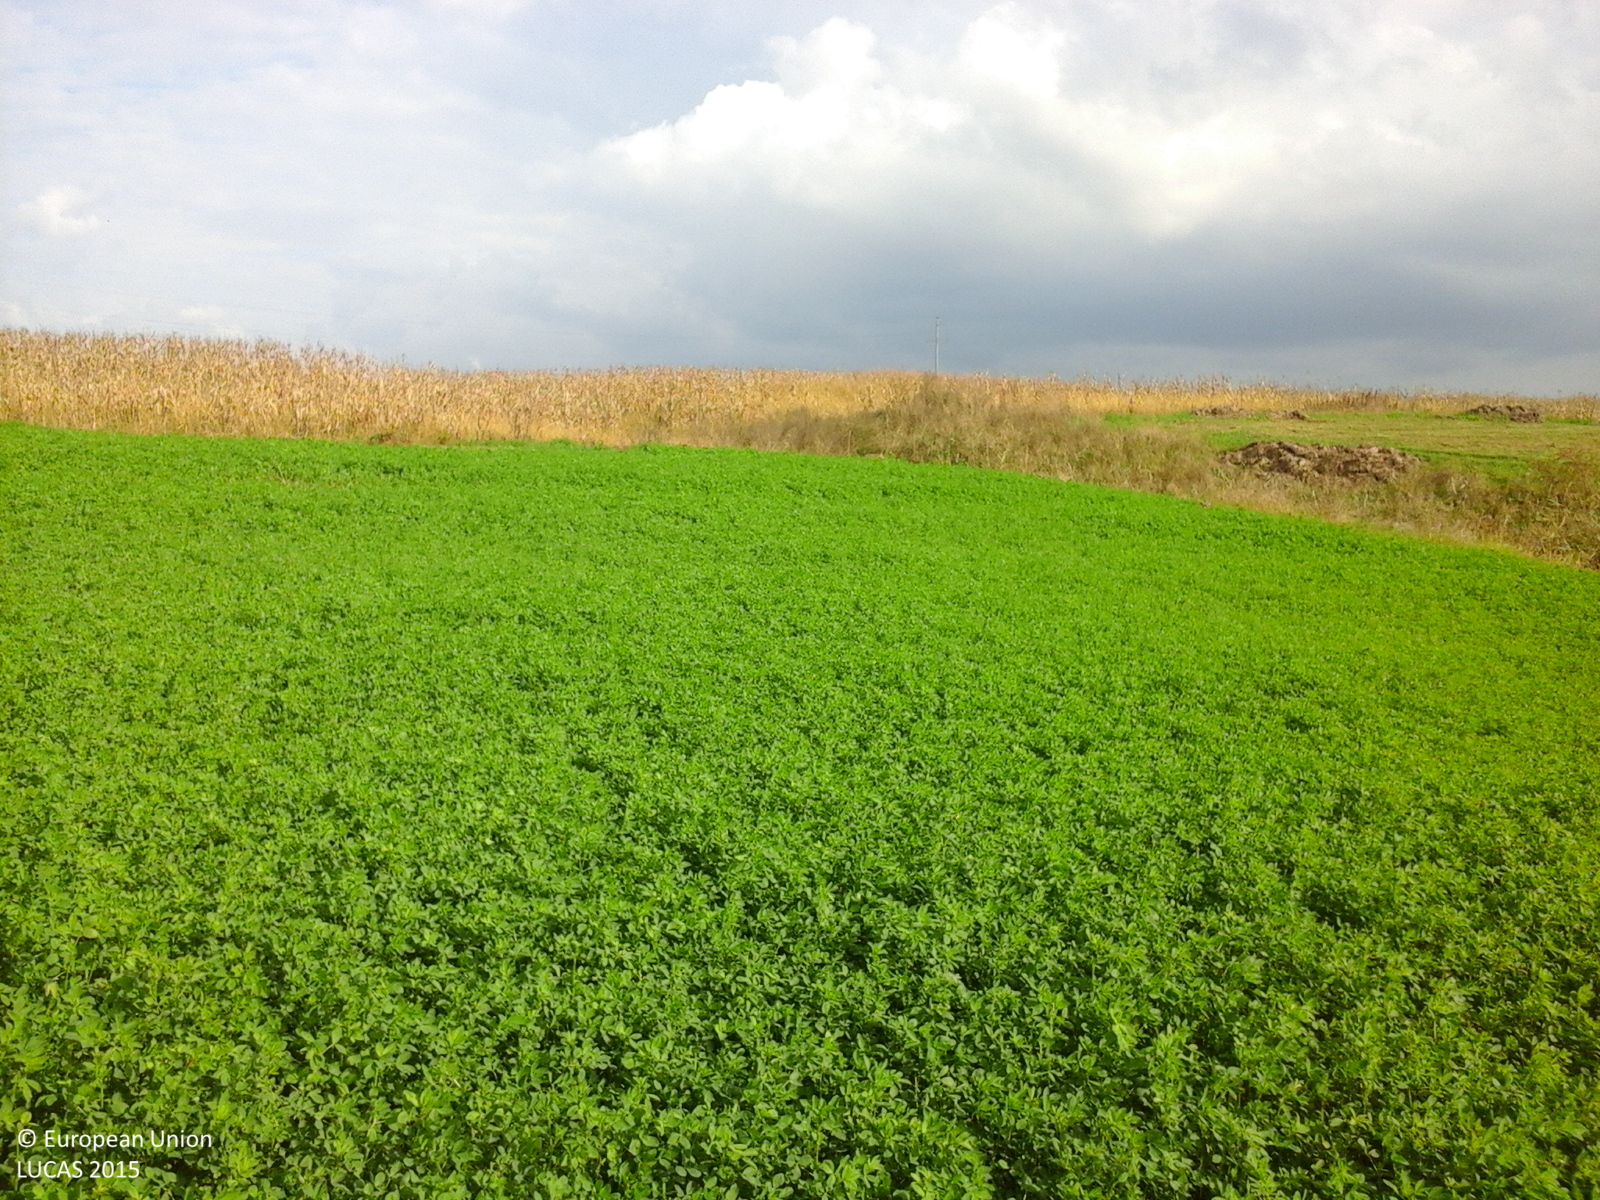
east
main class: Cropland
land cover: Lucerne
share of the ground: > 75 %
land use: Agriculture (excluding fallow land and kitchen gardens)
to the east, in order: Lucerne; Maize; Spontaneously vegetated surfaces; Sunflower; Grass margins; Tracks; Grassland without tree/shrub cover; Electric lines; Grassland without tree/shrub cover; Spontaneously vegetated surfaces
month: October
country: RO
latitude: 46.2458
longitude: 24.2828
